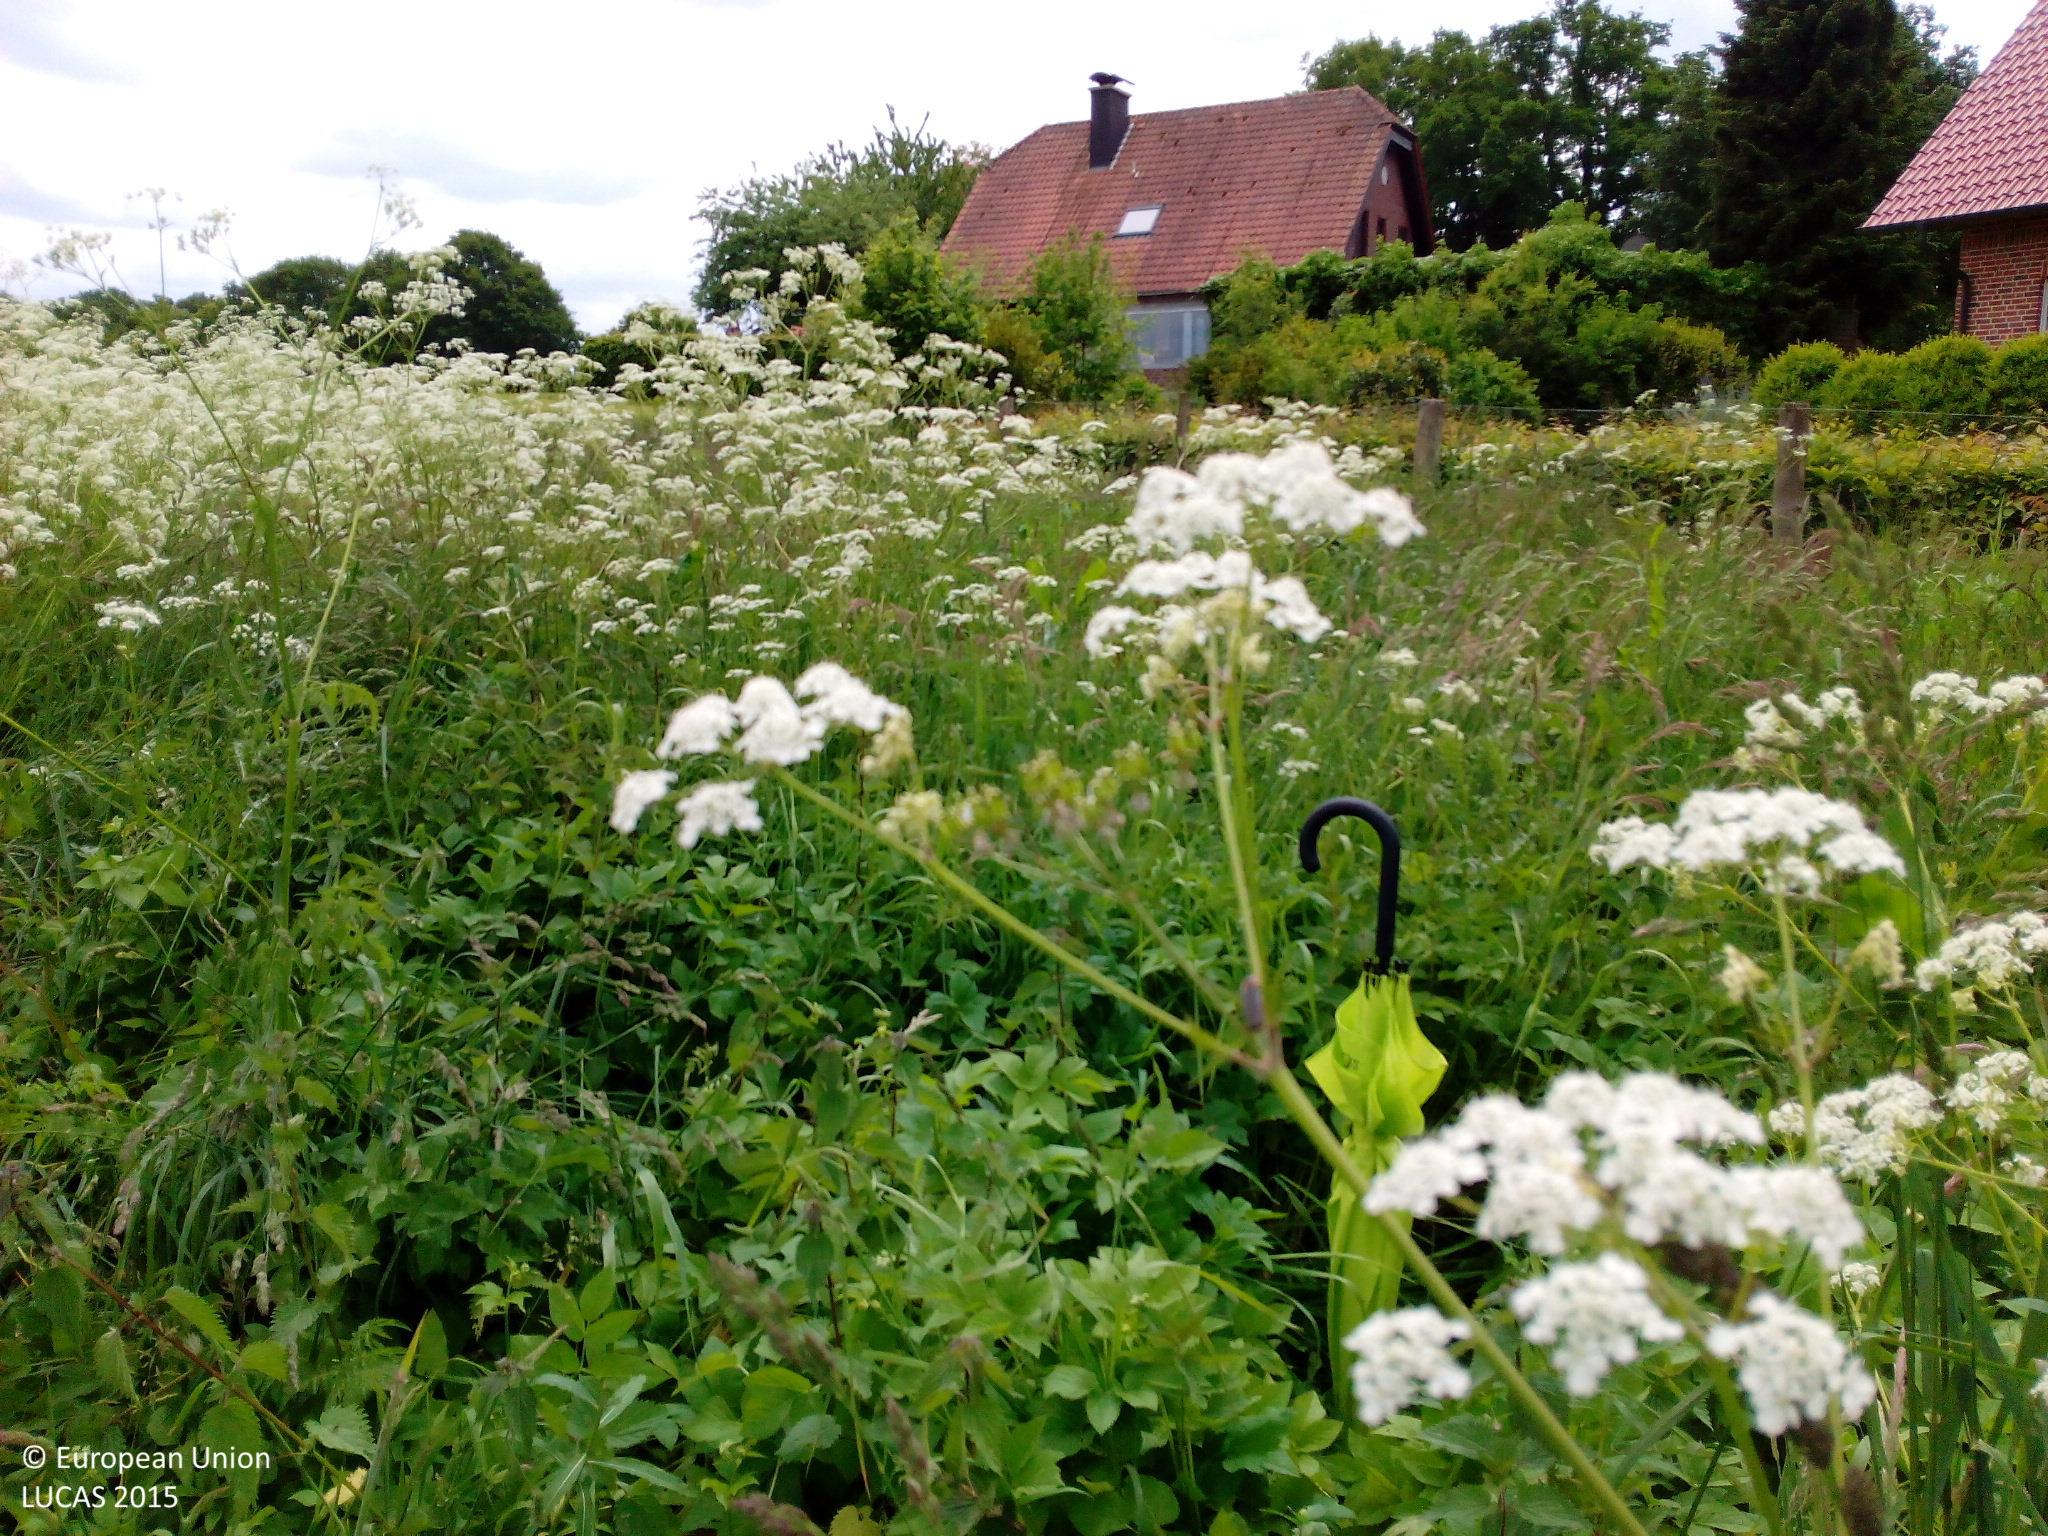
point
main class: Grassland
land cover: Grassland without tree/shrub cover
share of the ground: > 75 %
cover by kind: herbaceous plants 100 %
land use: Agriculture (excluding fallow land and kitchen gardens)
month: June
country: DE
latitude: 52.3125
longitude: 7.3747
